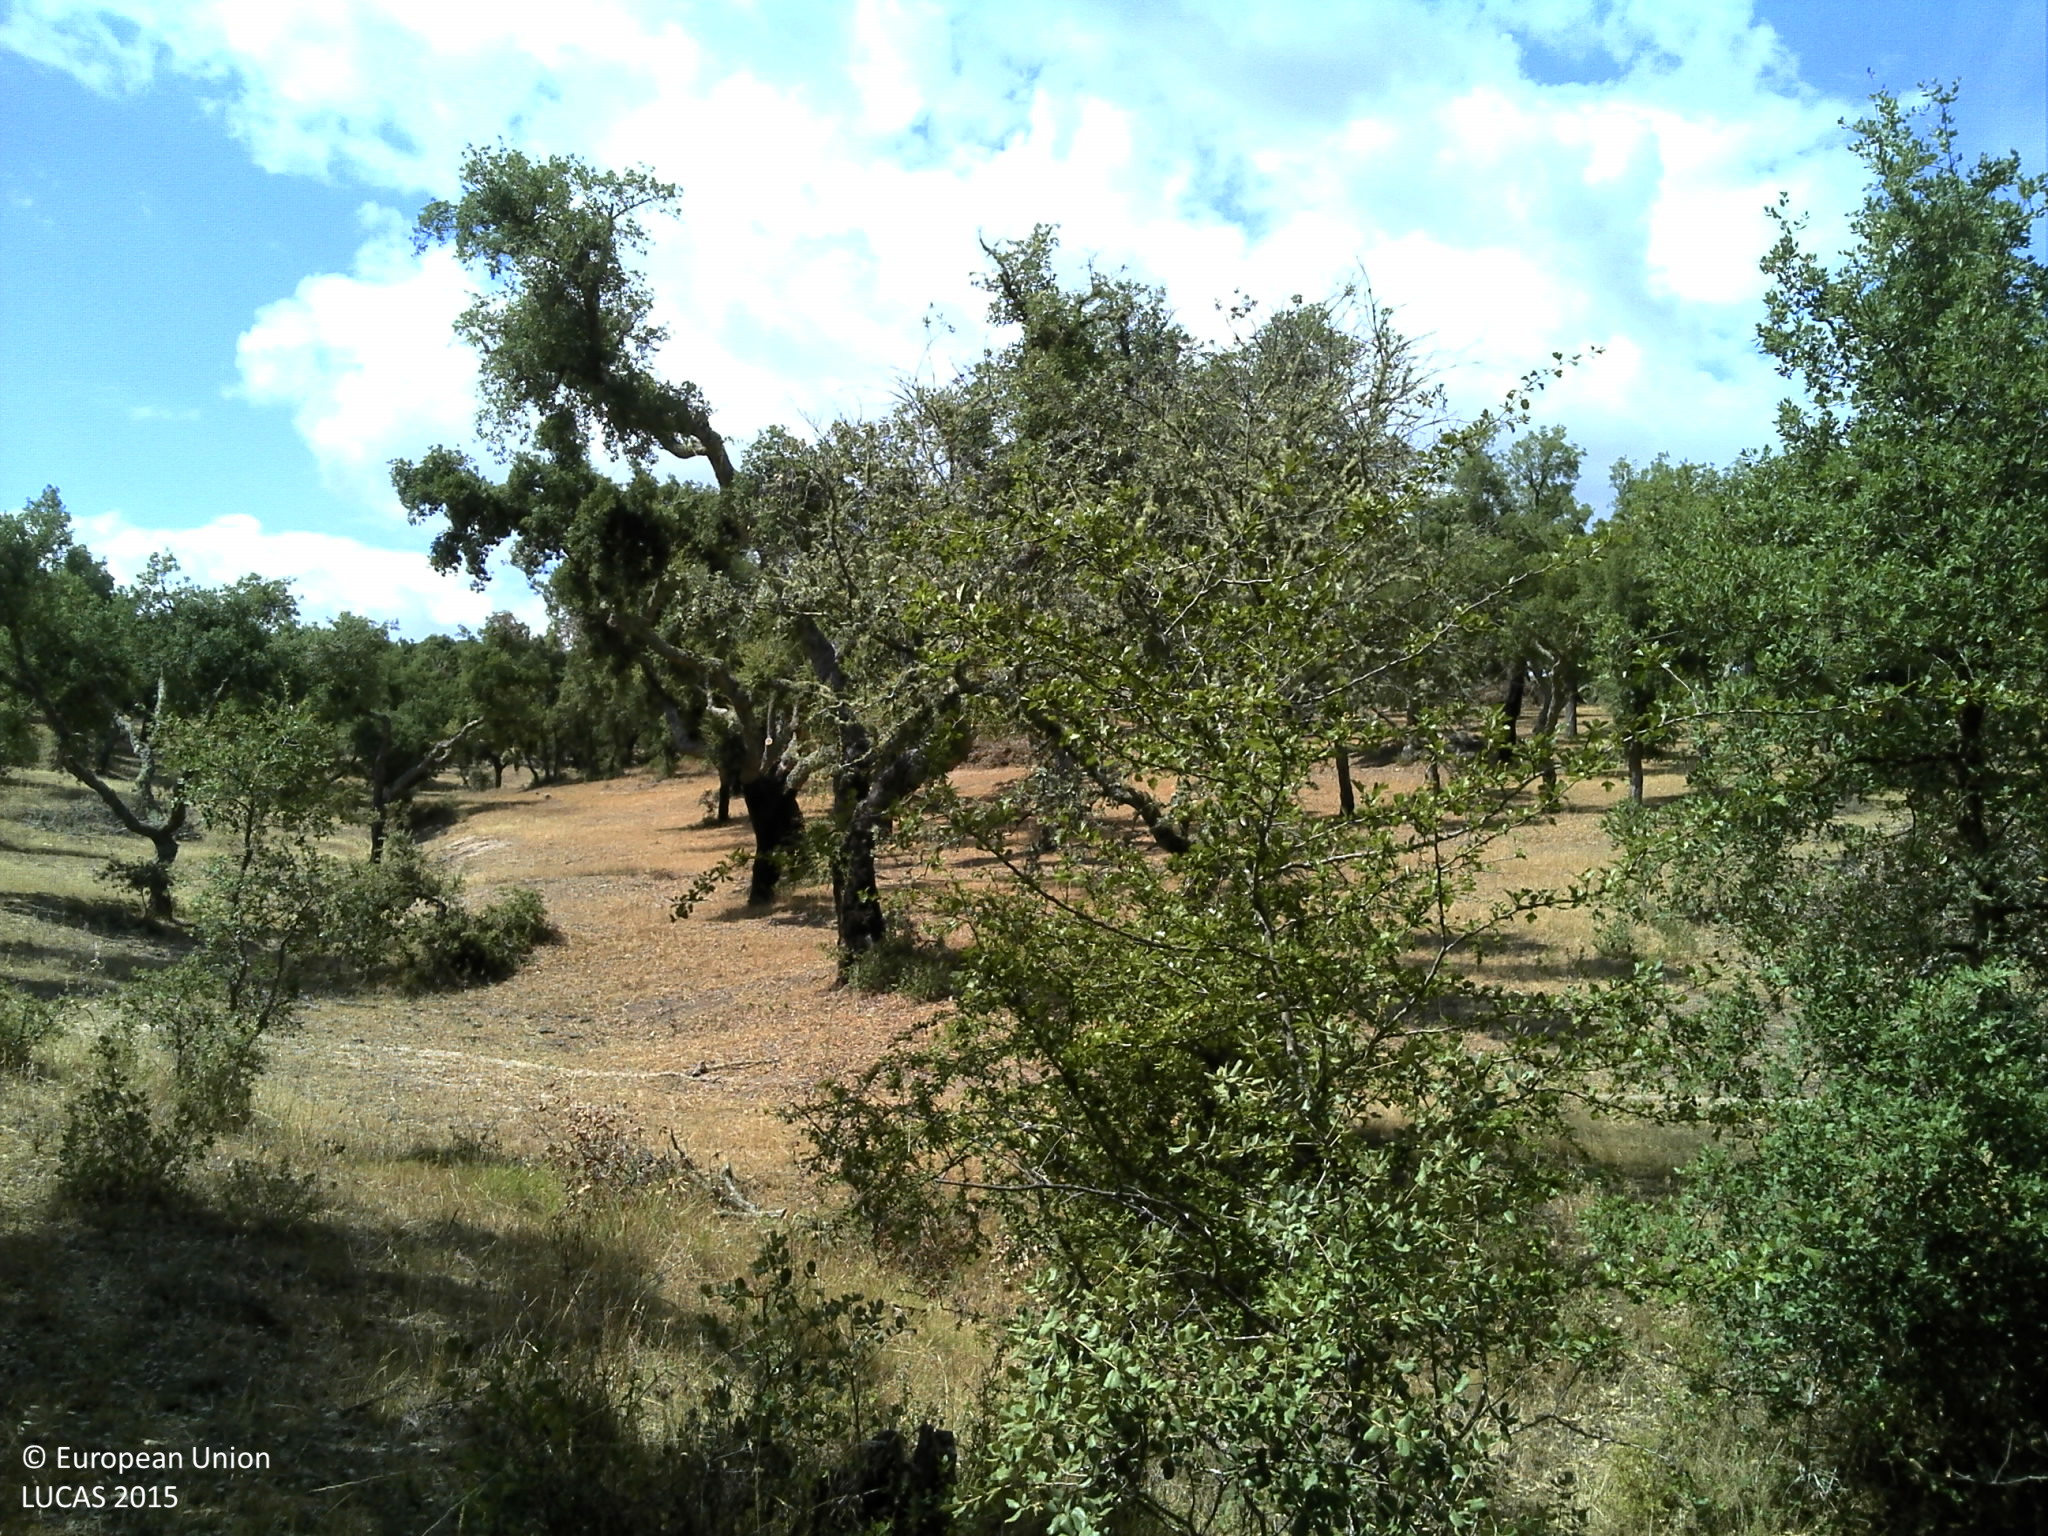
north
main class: Woodland
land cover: Broadleaved woodland
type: broadleaved evergreen forest
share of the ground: > 75 %
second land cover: Grassland without tree/shrub cover
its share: 10 - 25 %
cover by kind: broadleaved forest trees 80 %, herbaceous plants 10 %, unconsolidated bare surface 10 %
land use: Forestry
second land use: Agriculture (excluding fallow land and kitchen gardens)
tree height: > 5 m
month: June
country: PT
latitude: 38.5726
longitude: -8.0754
